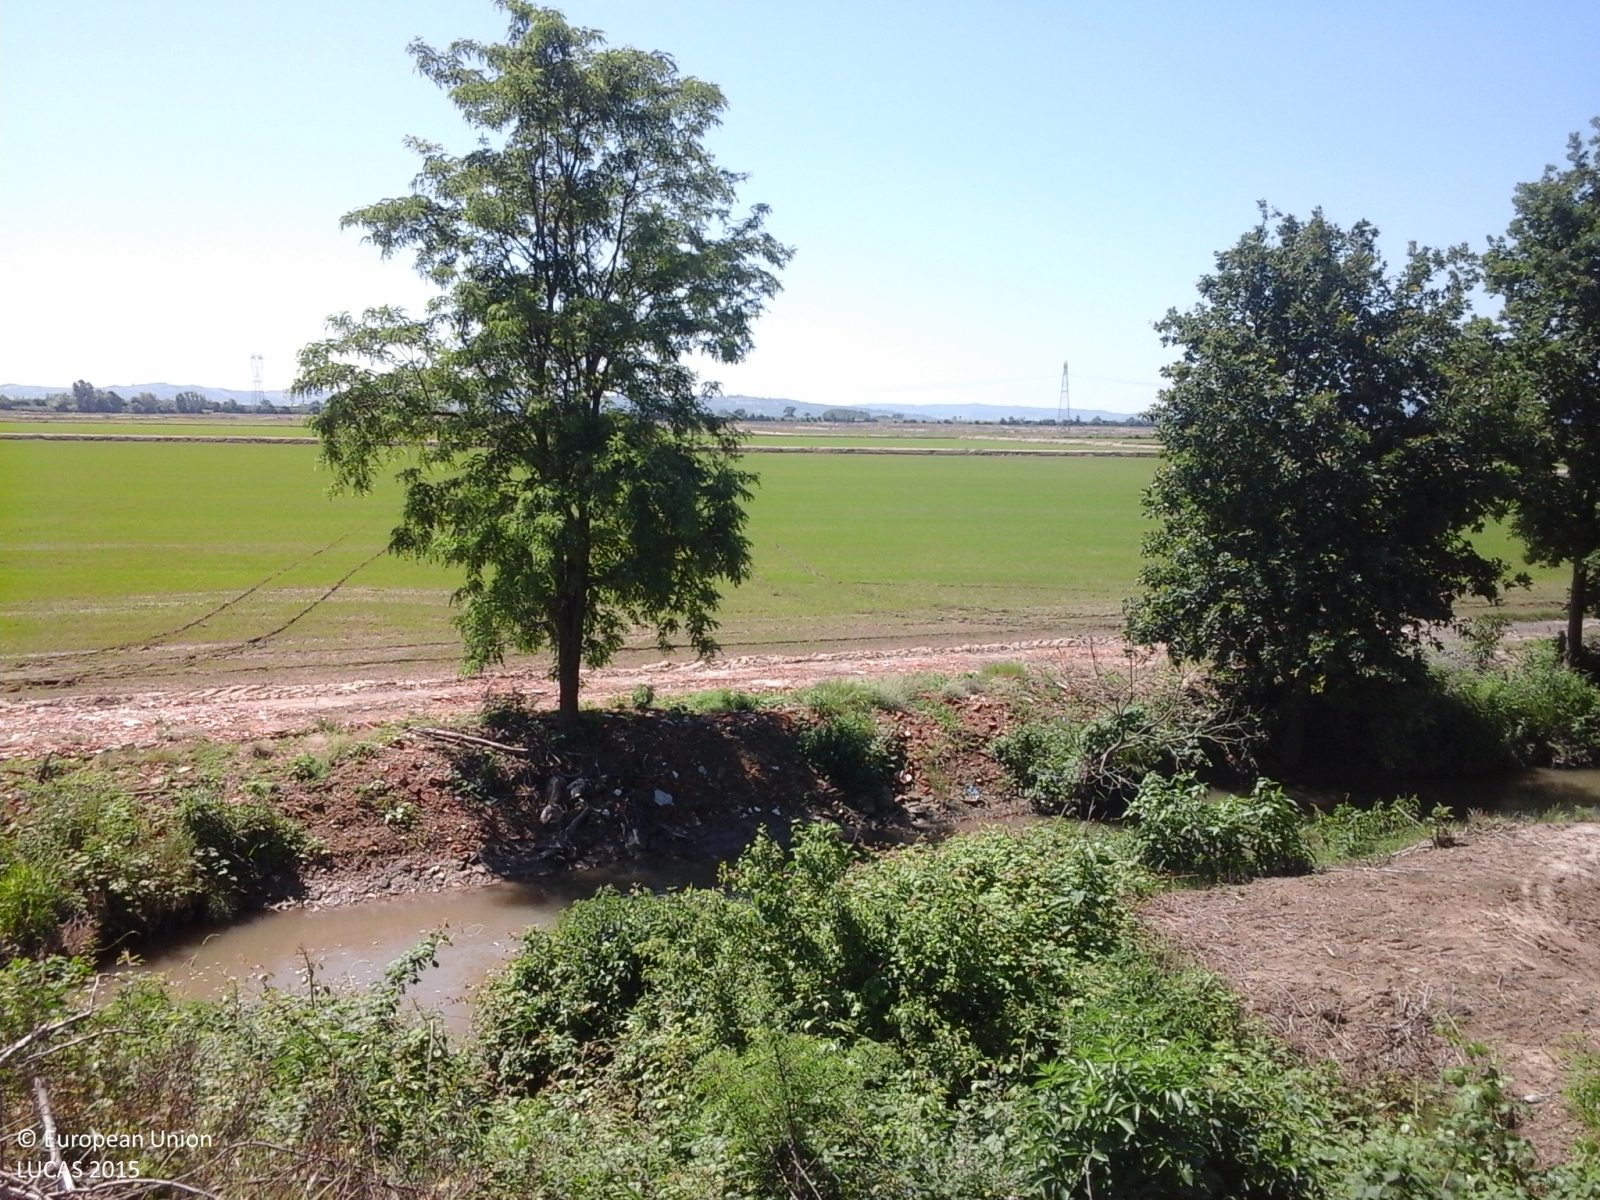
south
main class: Cropland
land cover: Rice
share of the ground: < 10 %
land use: Agriculture (excluding fallow land and kitchen gardens)
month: May
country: IT
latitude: 45.2217
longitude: 8.3855
